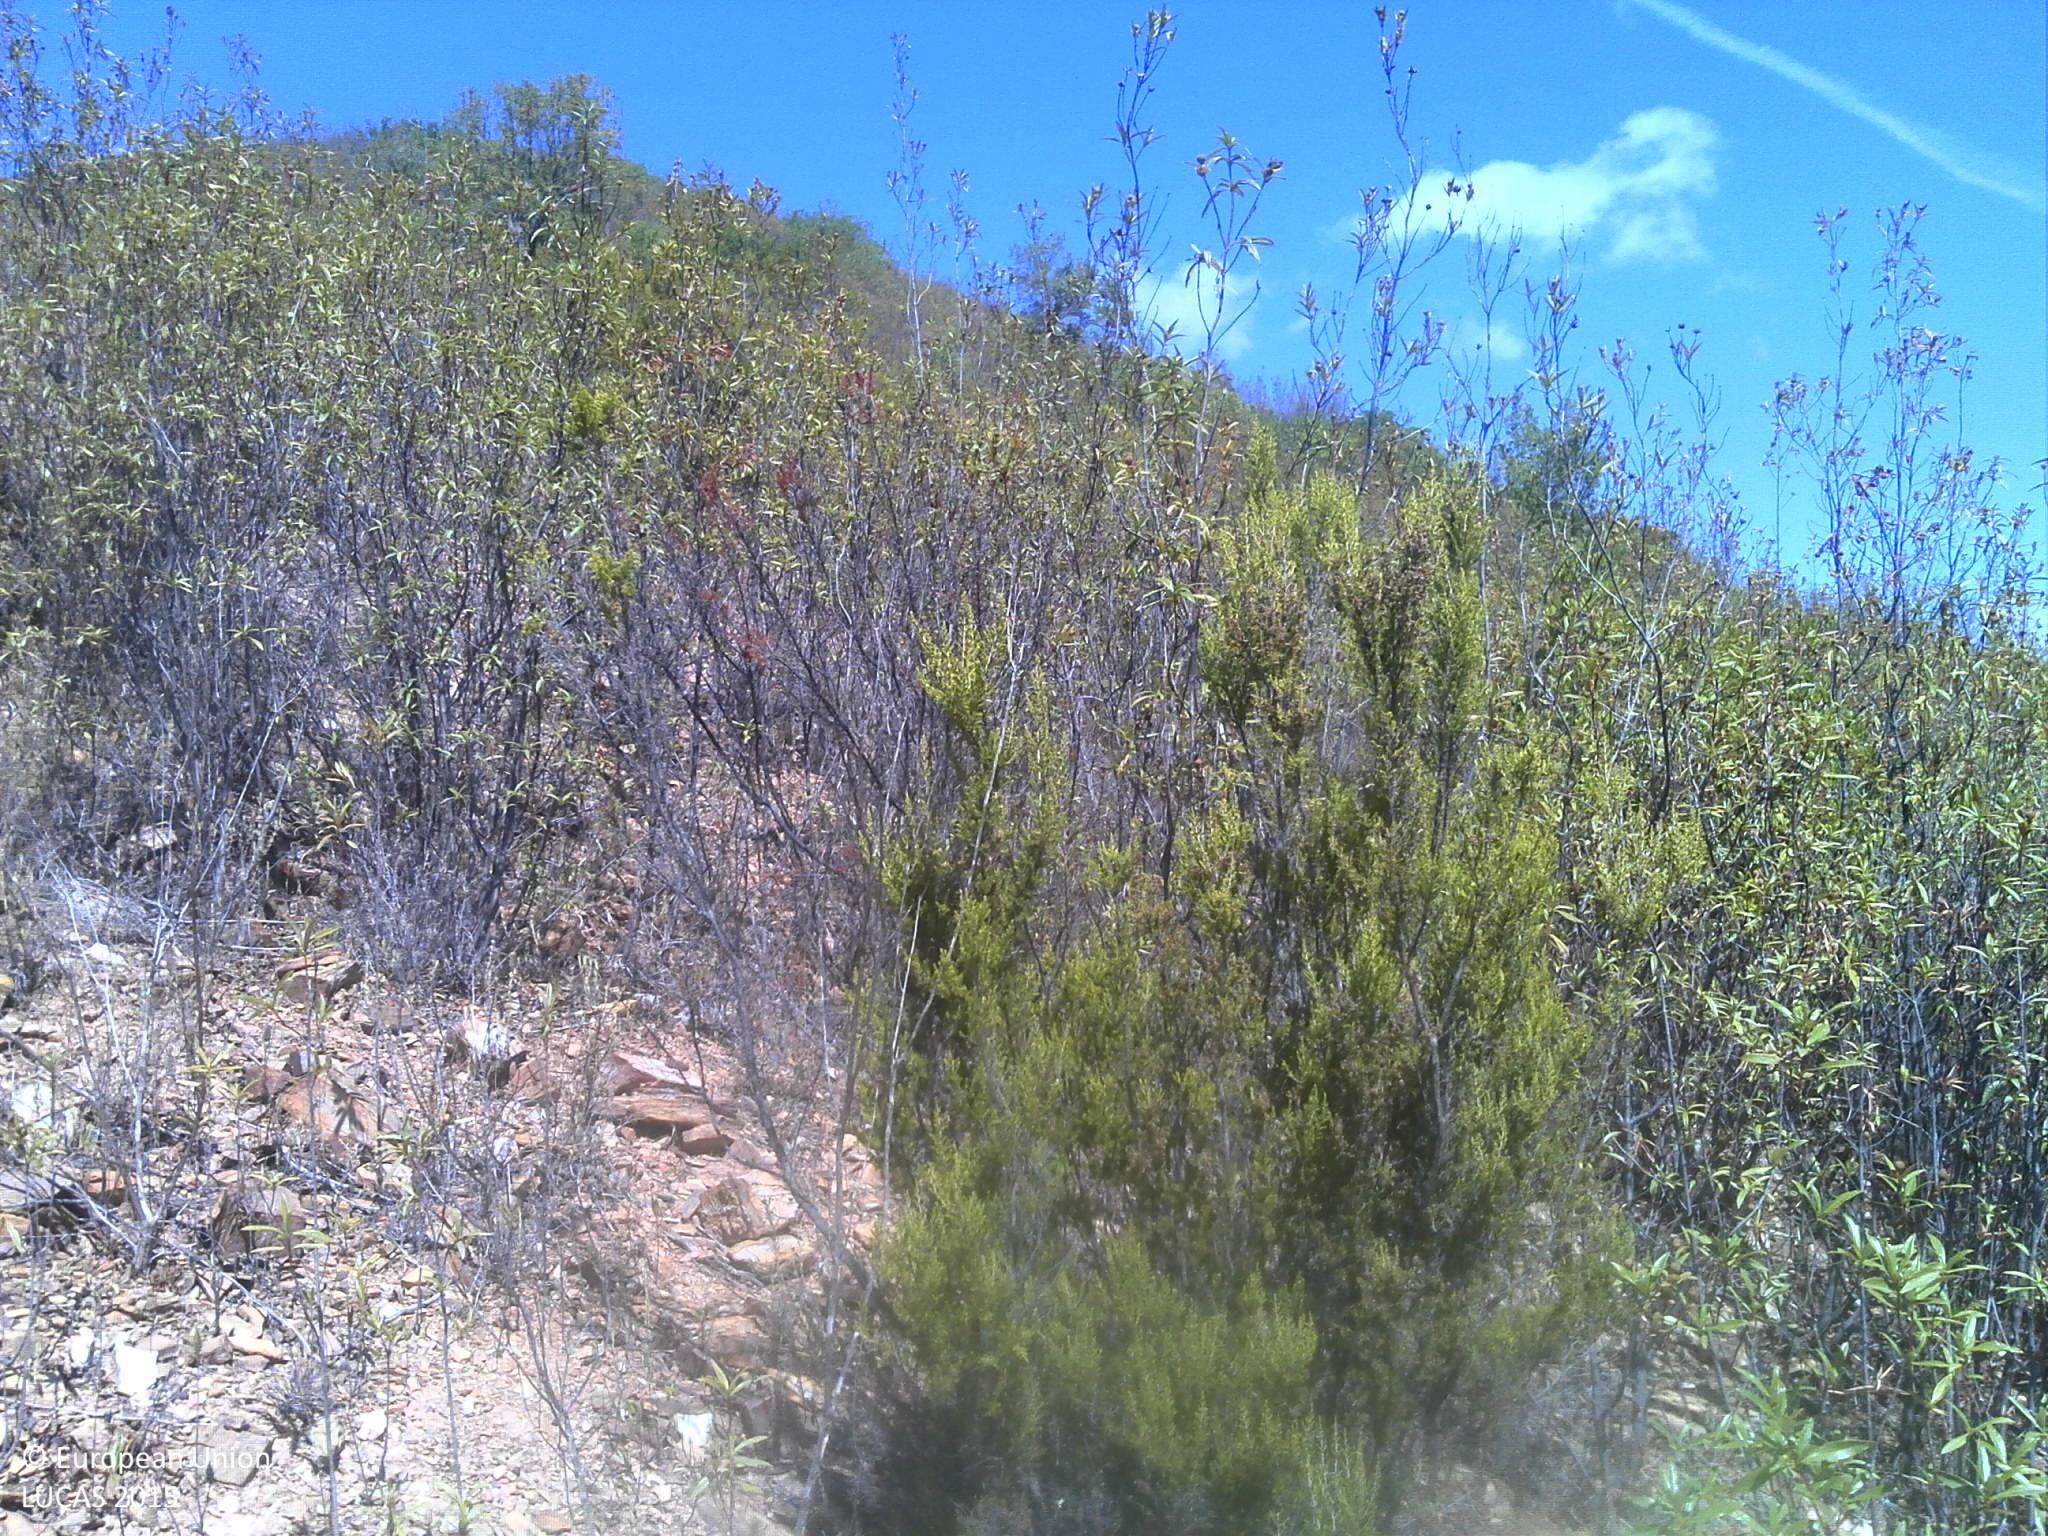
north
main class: Shrubland
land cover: Shrubland with sparse tree cover
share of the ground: 25 - 50 %
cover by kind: shrubs 50 %, unconsolidated bare surface 35 %, herbaceous plants 10 %, broadleaved forest trees 5 %
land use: Semi-natural and natural areas not in use
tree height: < 5 m
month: September
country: PT
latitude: 37.3269
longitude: -8.2025
